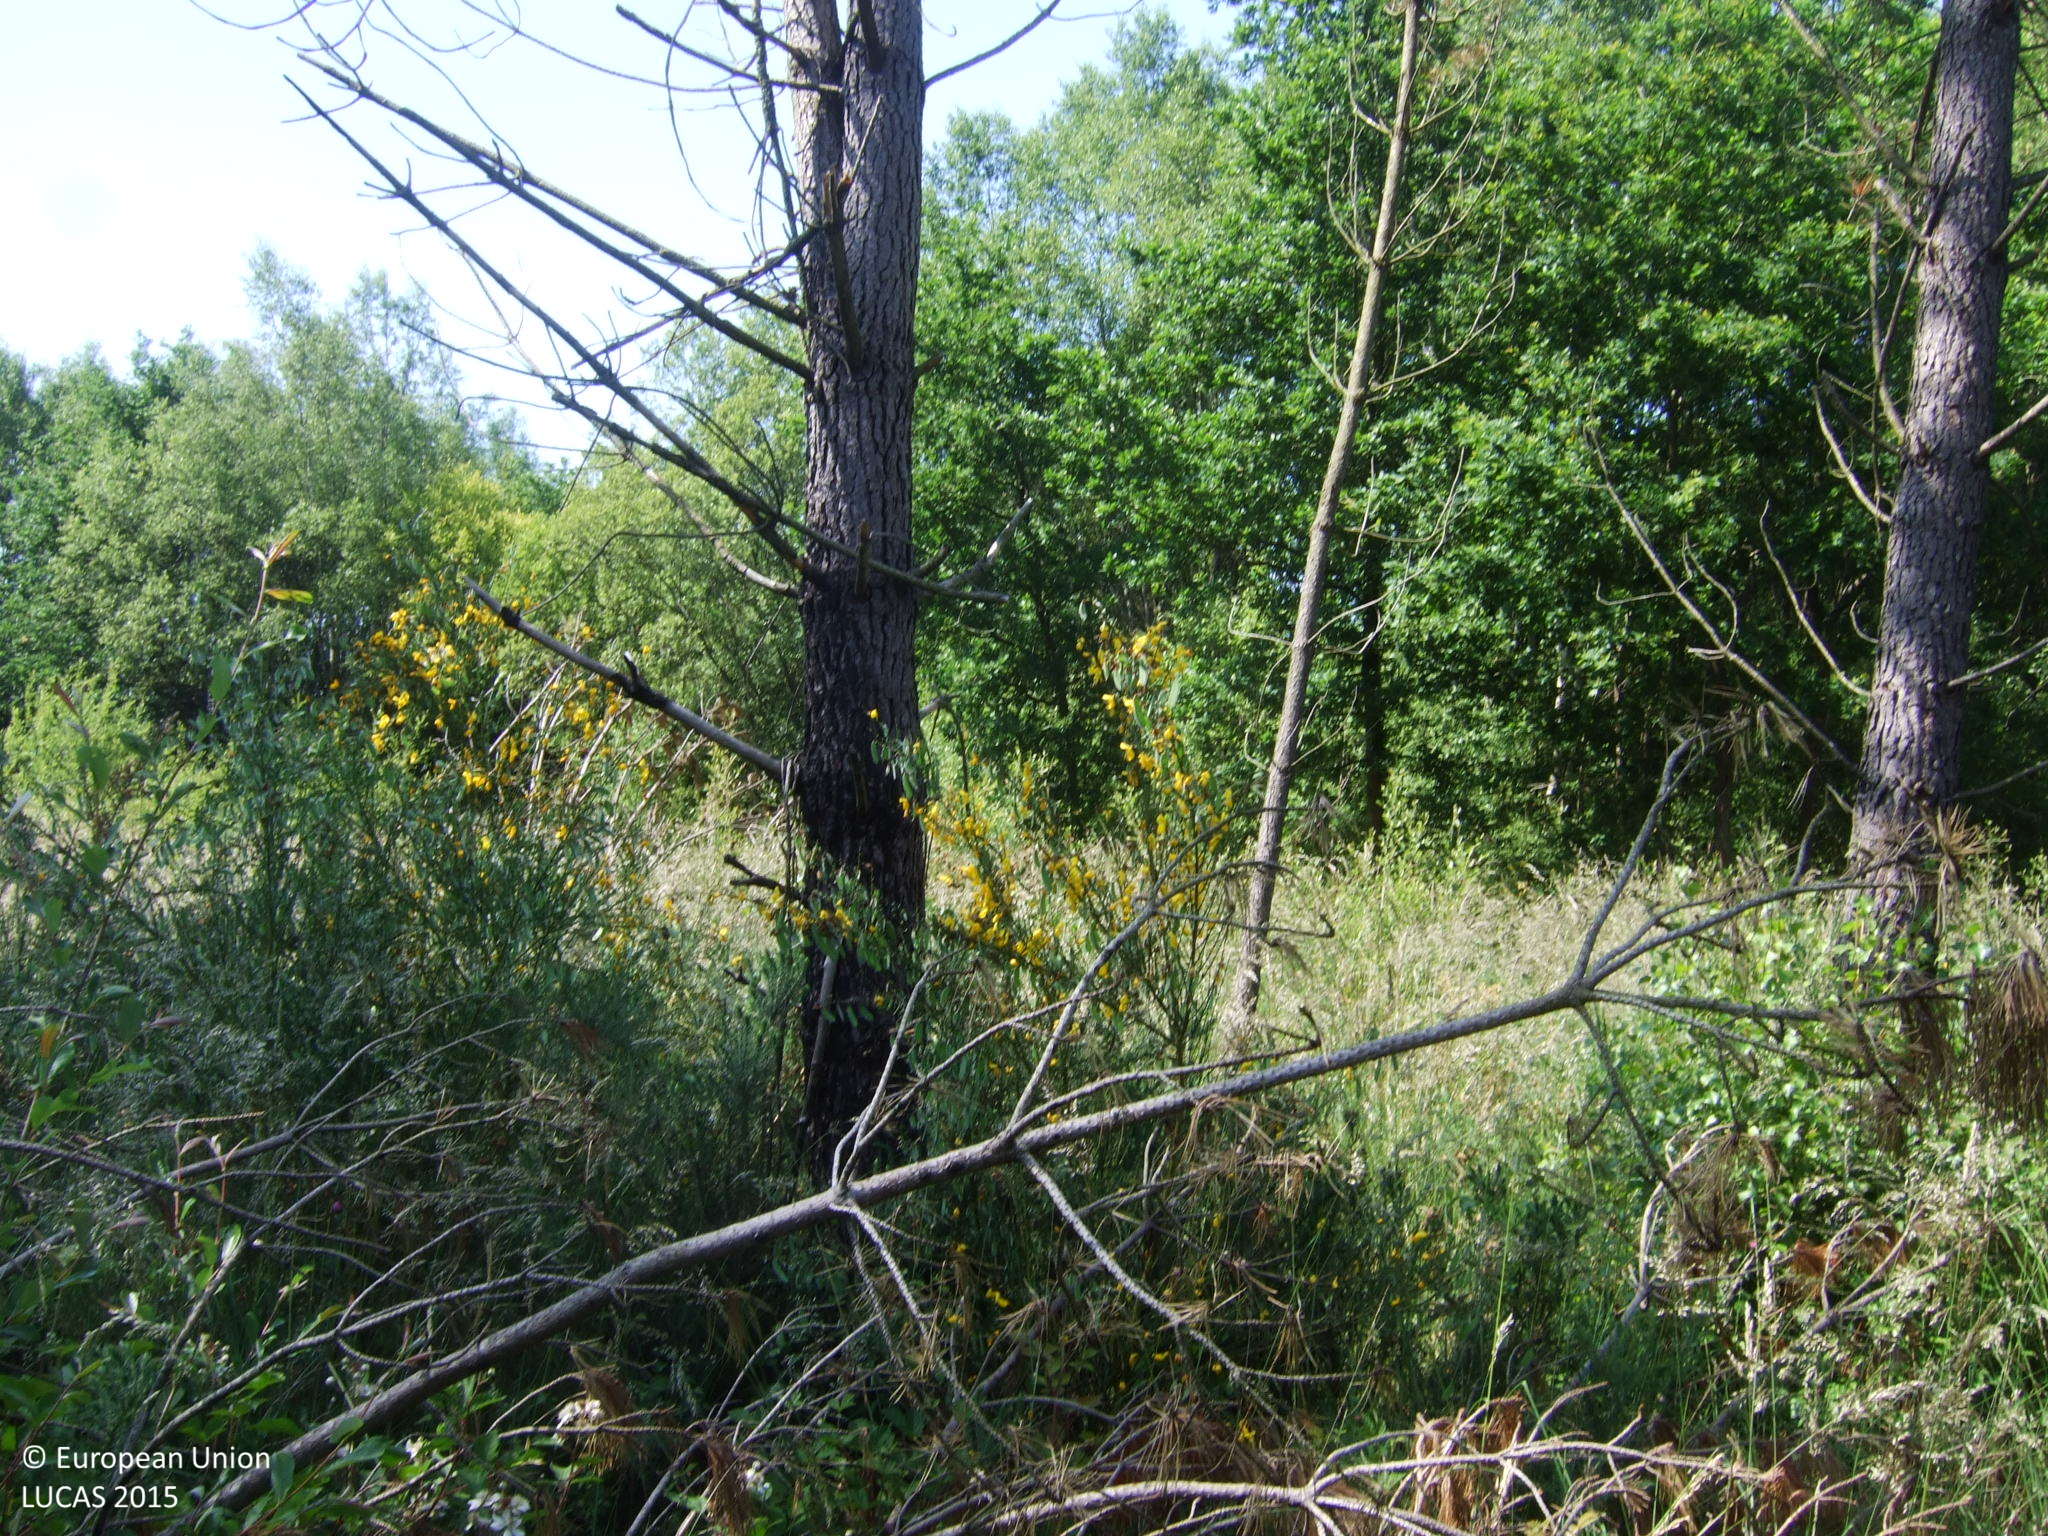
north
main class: Woodland
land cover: Pine dominated coniferous woodland
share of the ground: 25 - 50 %
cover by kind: shrubs 60 %, coniferous forest trees 40 %
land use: Forestry
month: June
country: ES
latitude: 43.2657
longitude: -7.4358
